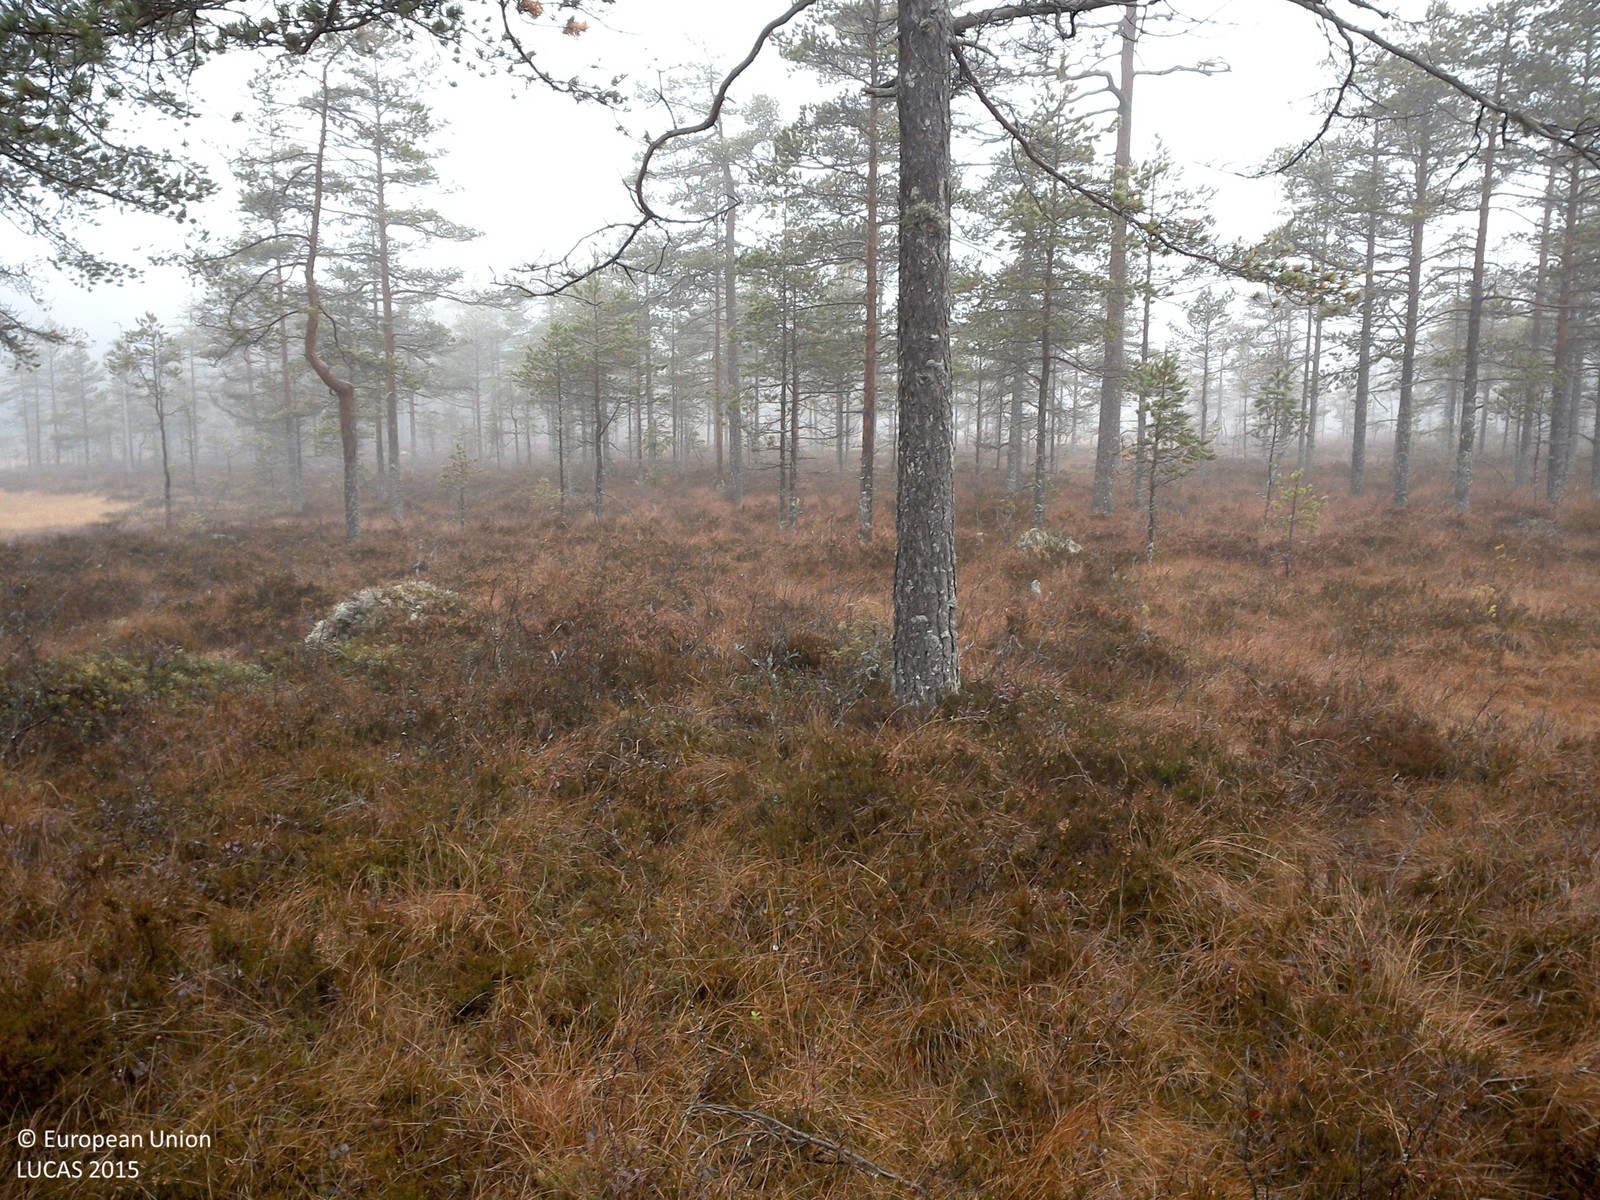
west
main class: Woodland
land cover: Pine dominated coniferous woodland
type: boreal forest
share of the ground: 25 - 50 %
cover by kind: coniferous forest trees 40 %, shrubs 30 %, herbaceous plants 15 %, lichens and mosses 15 %
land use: Forestry
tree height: > 5 m
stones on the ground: < 10 %
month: November
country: SE
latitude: 60.5901
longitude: 14.6796
